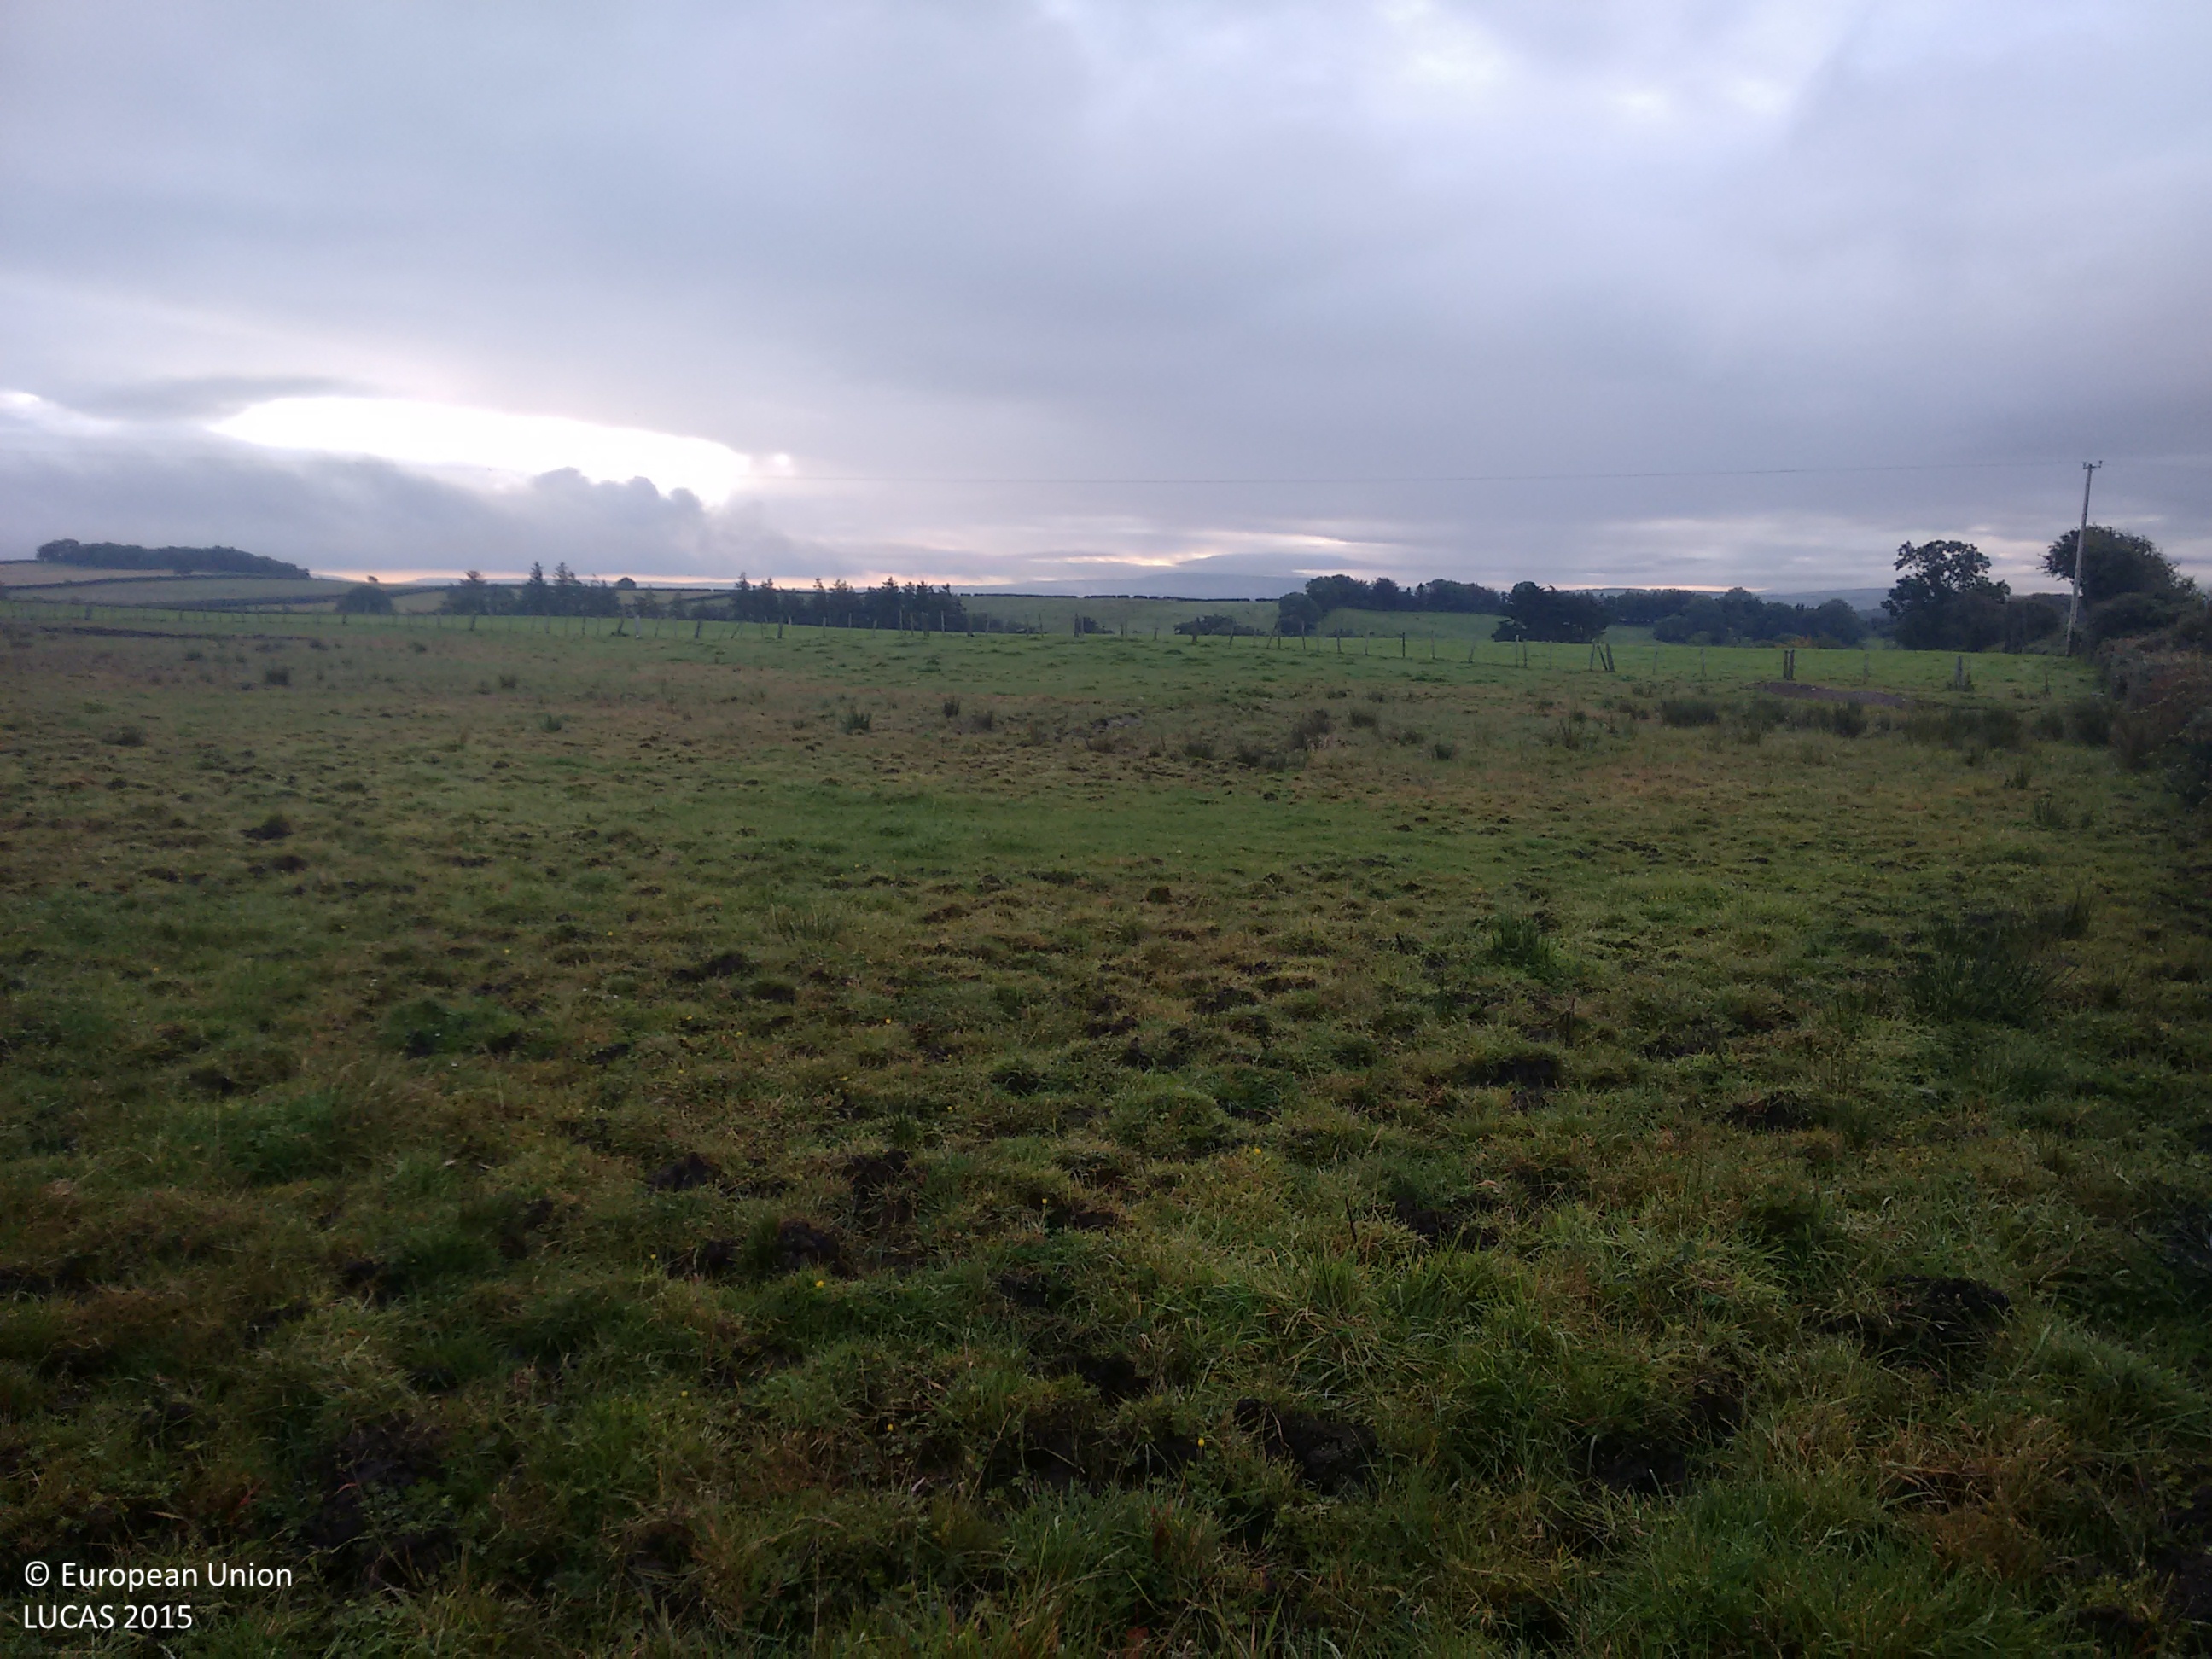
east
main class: Grassland
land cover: Grassland without tree/shrub cover
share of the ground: > 75 %
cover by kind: herbaceous plants 100 %
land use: Agriculture (excluding fallow land and kitchen gardens)
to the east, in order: Managed hedges; Grassland without tree/shrub cover; Fences; Grassland without tree/shrub cover
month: September
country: IE
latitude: 55.0513
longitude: -7.3192
